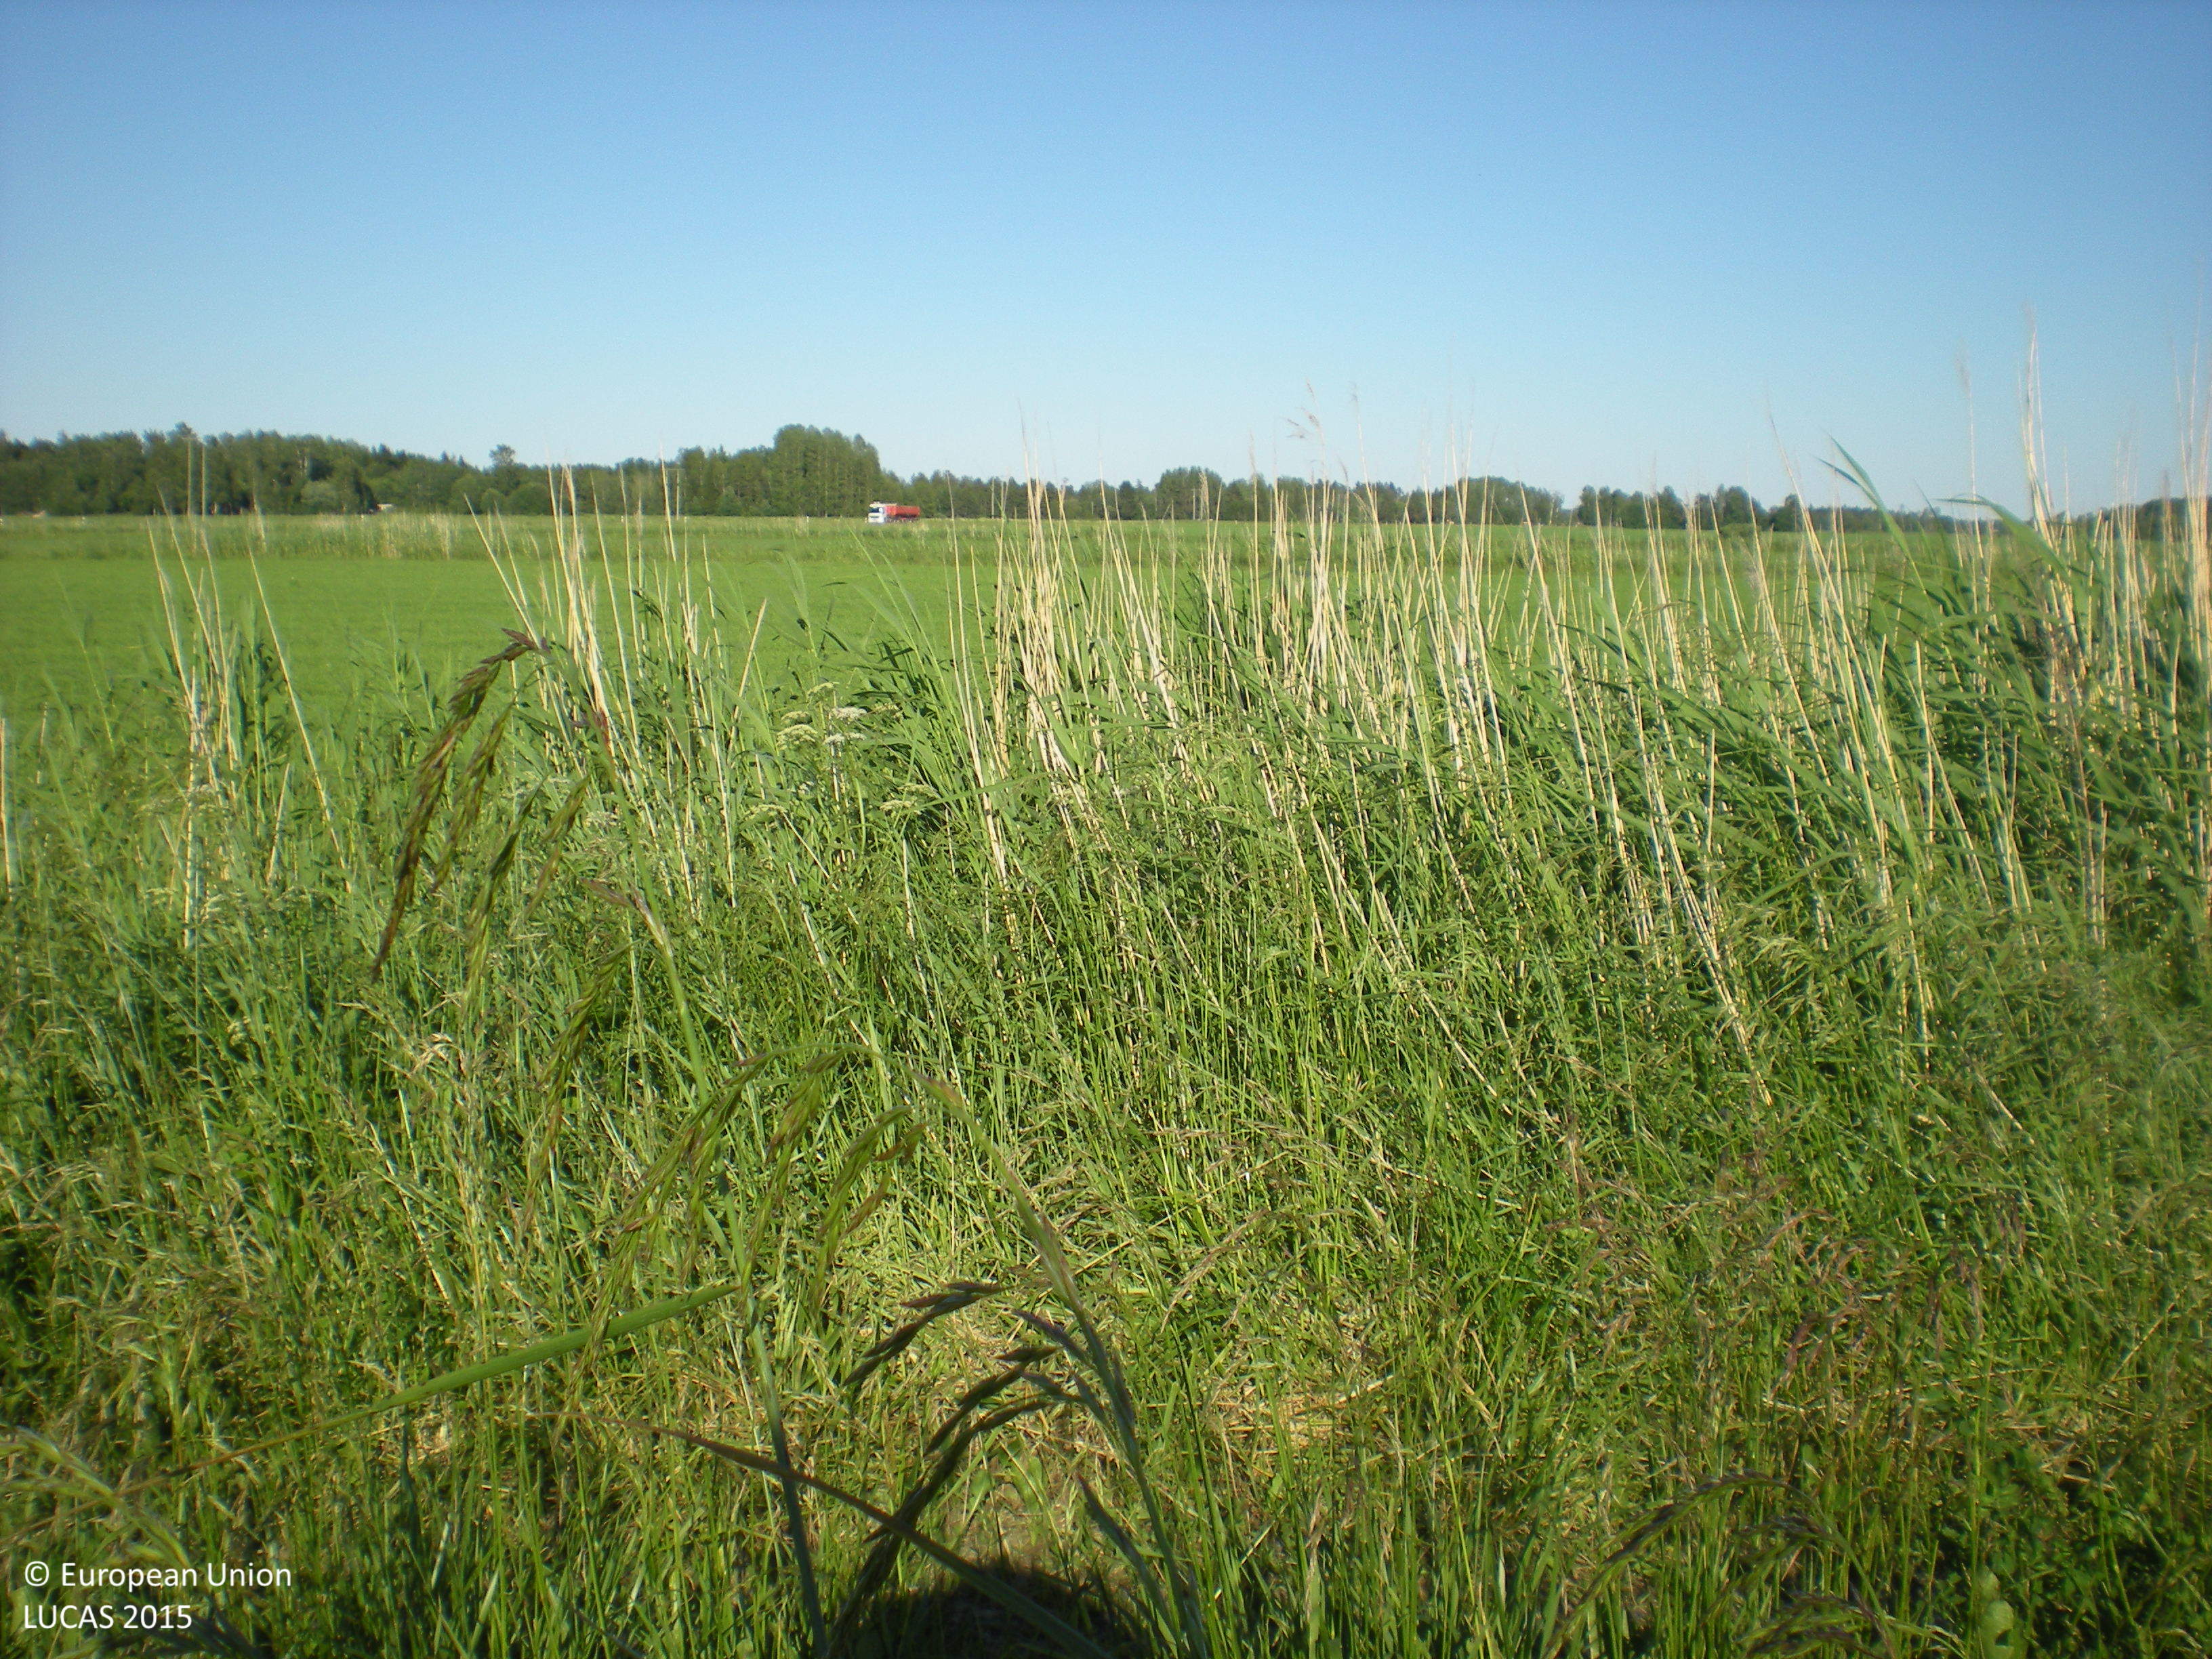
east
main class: Cropland
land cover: Barley
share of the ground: > 75 %
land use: Agriculture (excluding fallow land and kitchen gardens)
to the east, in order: Ditches and canals; Grass margins; Tracks; Grass margins; Ditches and canals; Barley; Ditches and canals; Grass margins; Ditches and canals; Temporary grasslands; Grass margins
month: July
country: SE
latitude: 60.4955
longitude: 17.6914
